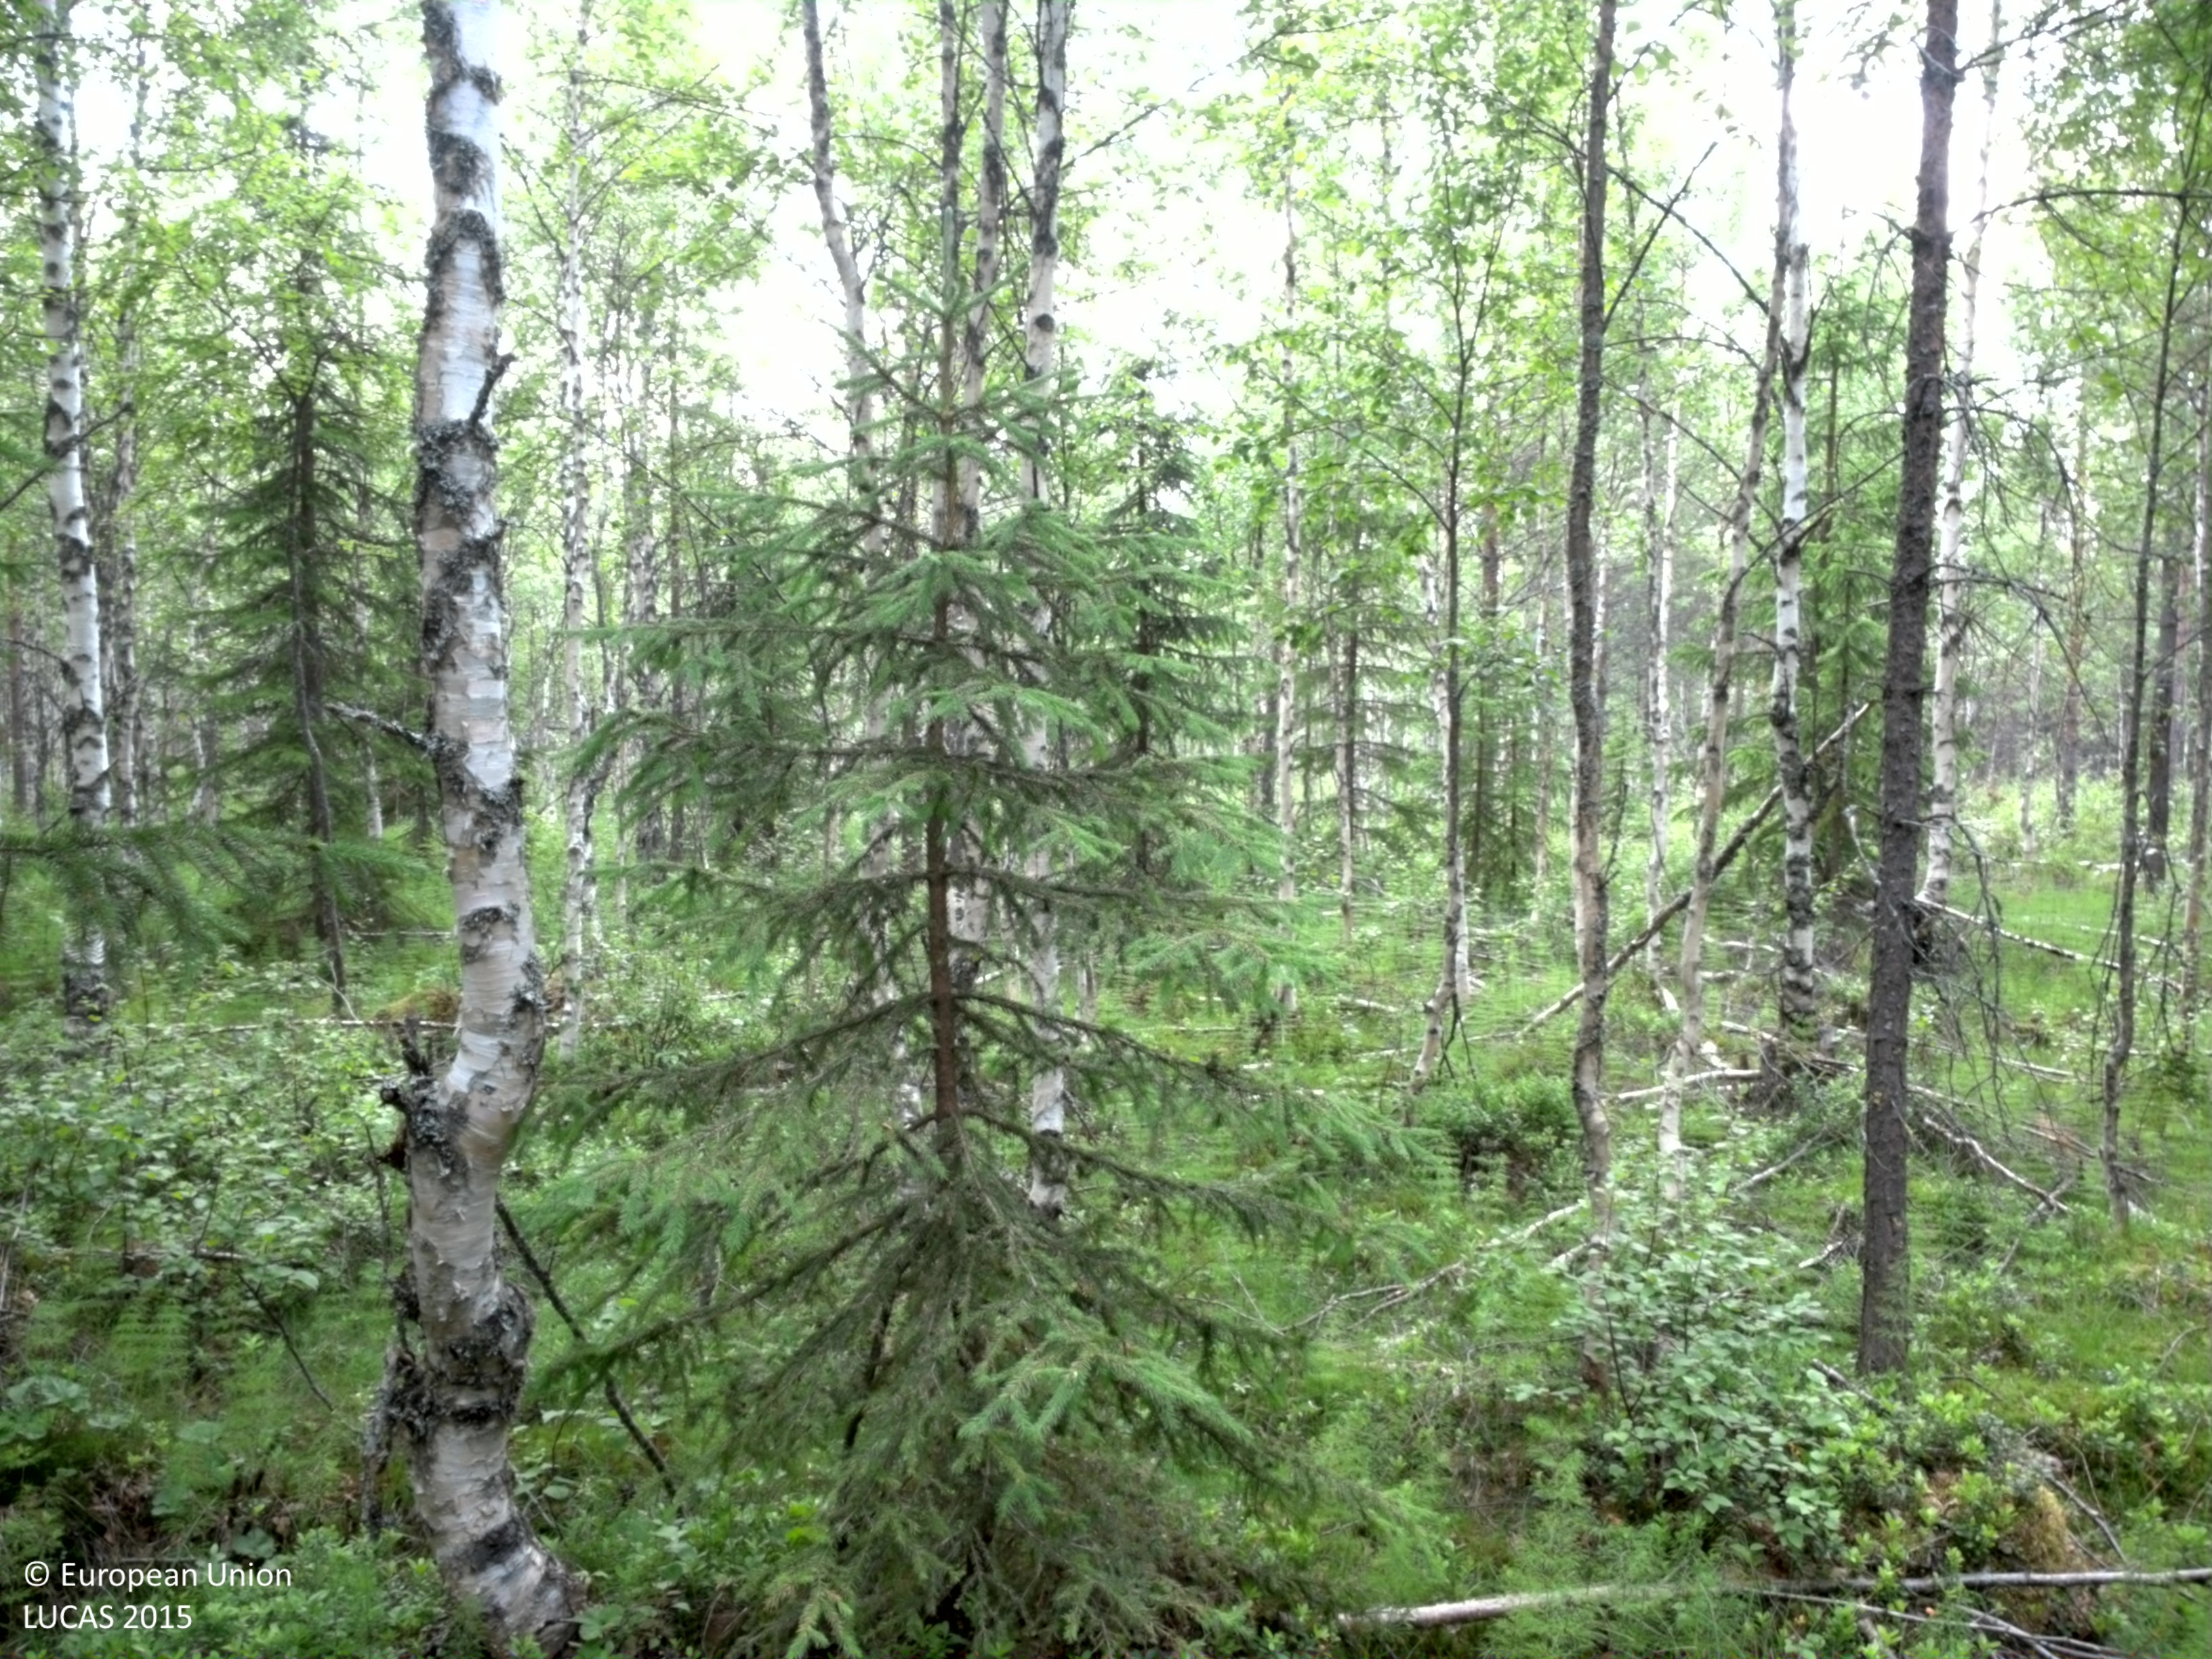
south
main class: Woodland
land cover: Other mixed woodland
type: boreal forest
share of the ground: 50 - 75 %
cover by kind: coniferous forest trees 45 %, broadleaved forest trees 25 %, shrubs 15 %, herbaceous plants 15 %
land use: Forestry
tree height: > 5 m
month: July
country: SE
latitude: 64.4756
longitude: 20.9422
